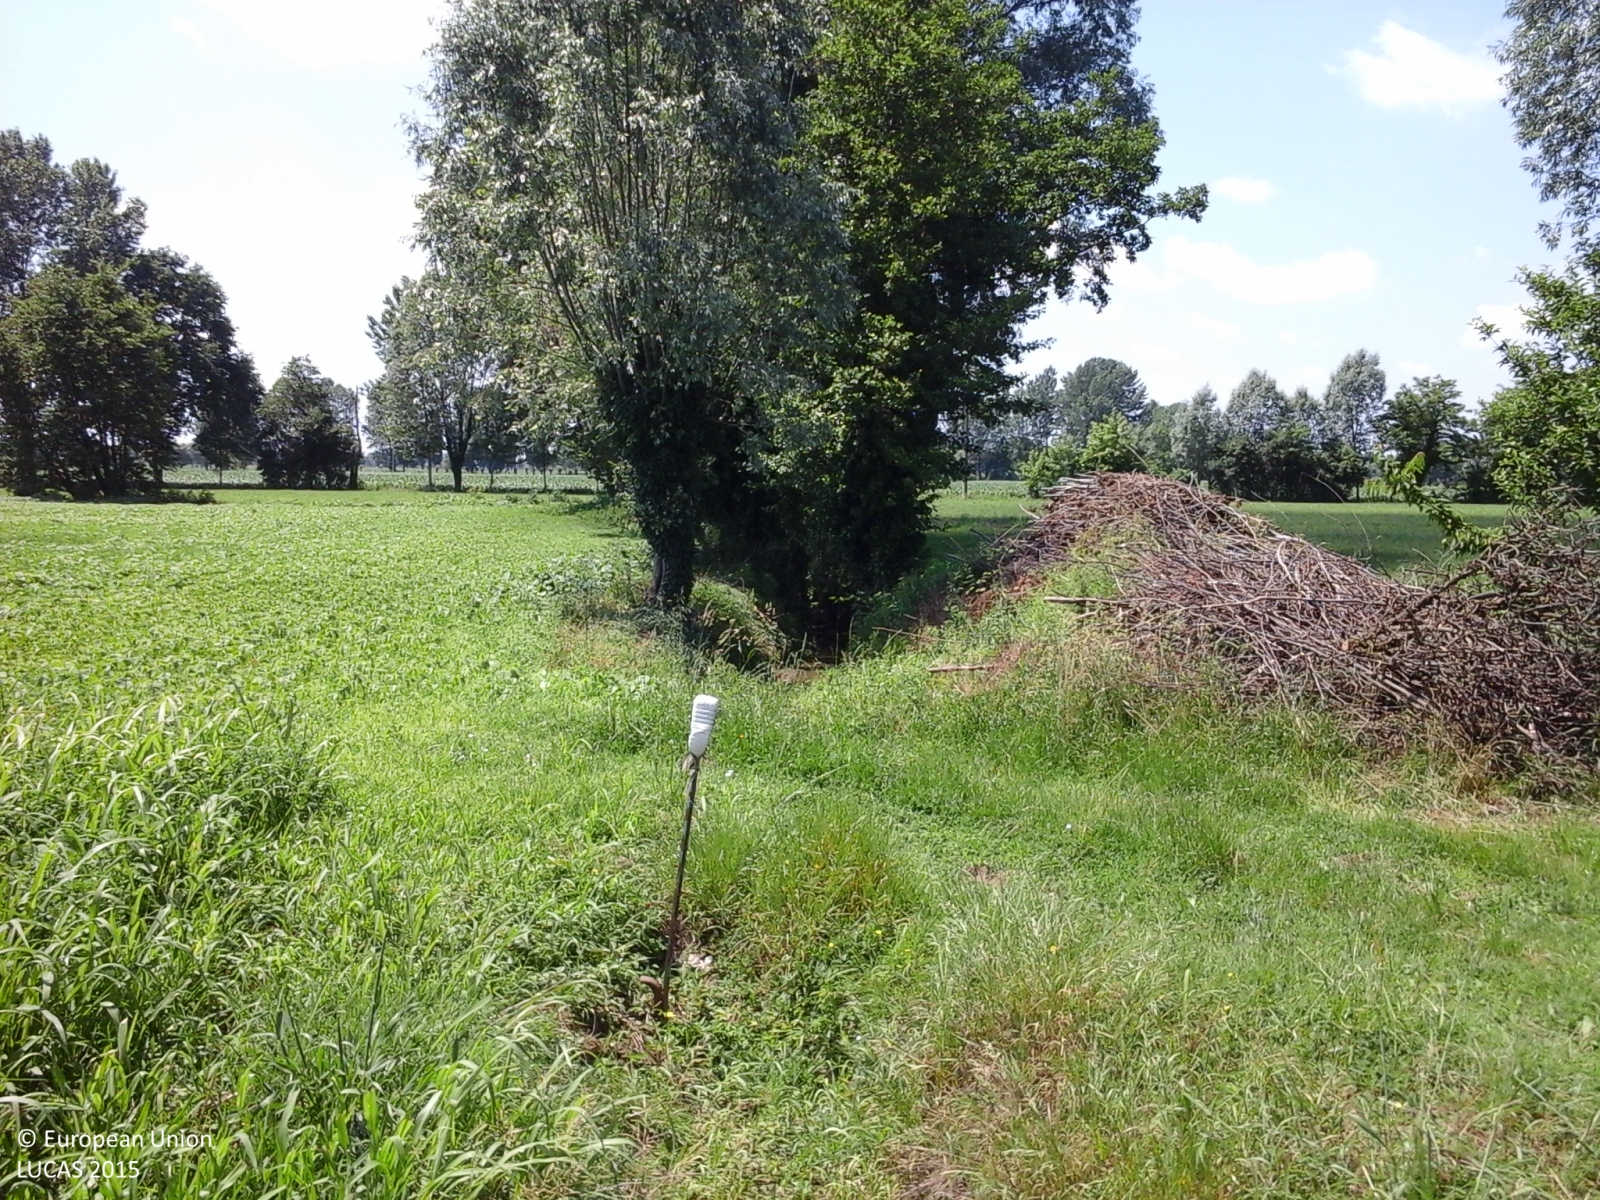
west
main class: Cropland
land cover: Lucerne
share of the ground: > 75 %
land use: Agriculture (excluding fallow land and kitchen gardens)
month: May
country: IT
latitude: 45.4318
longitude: 9.6555
